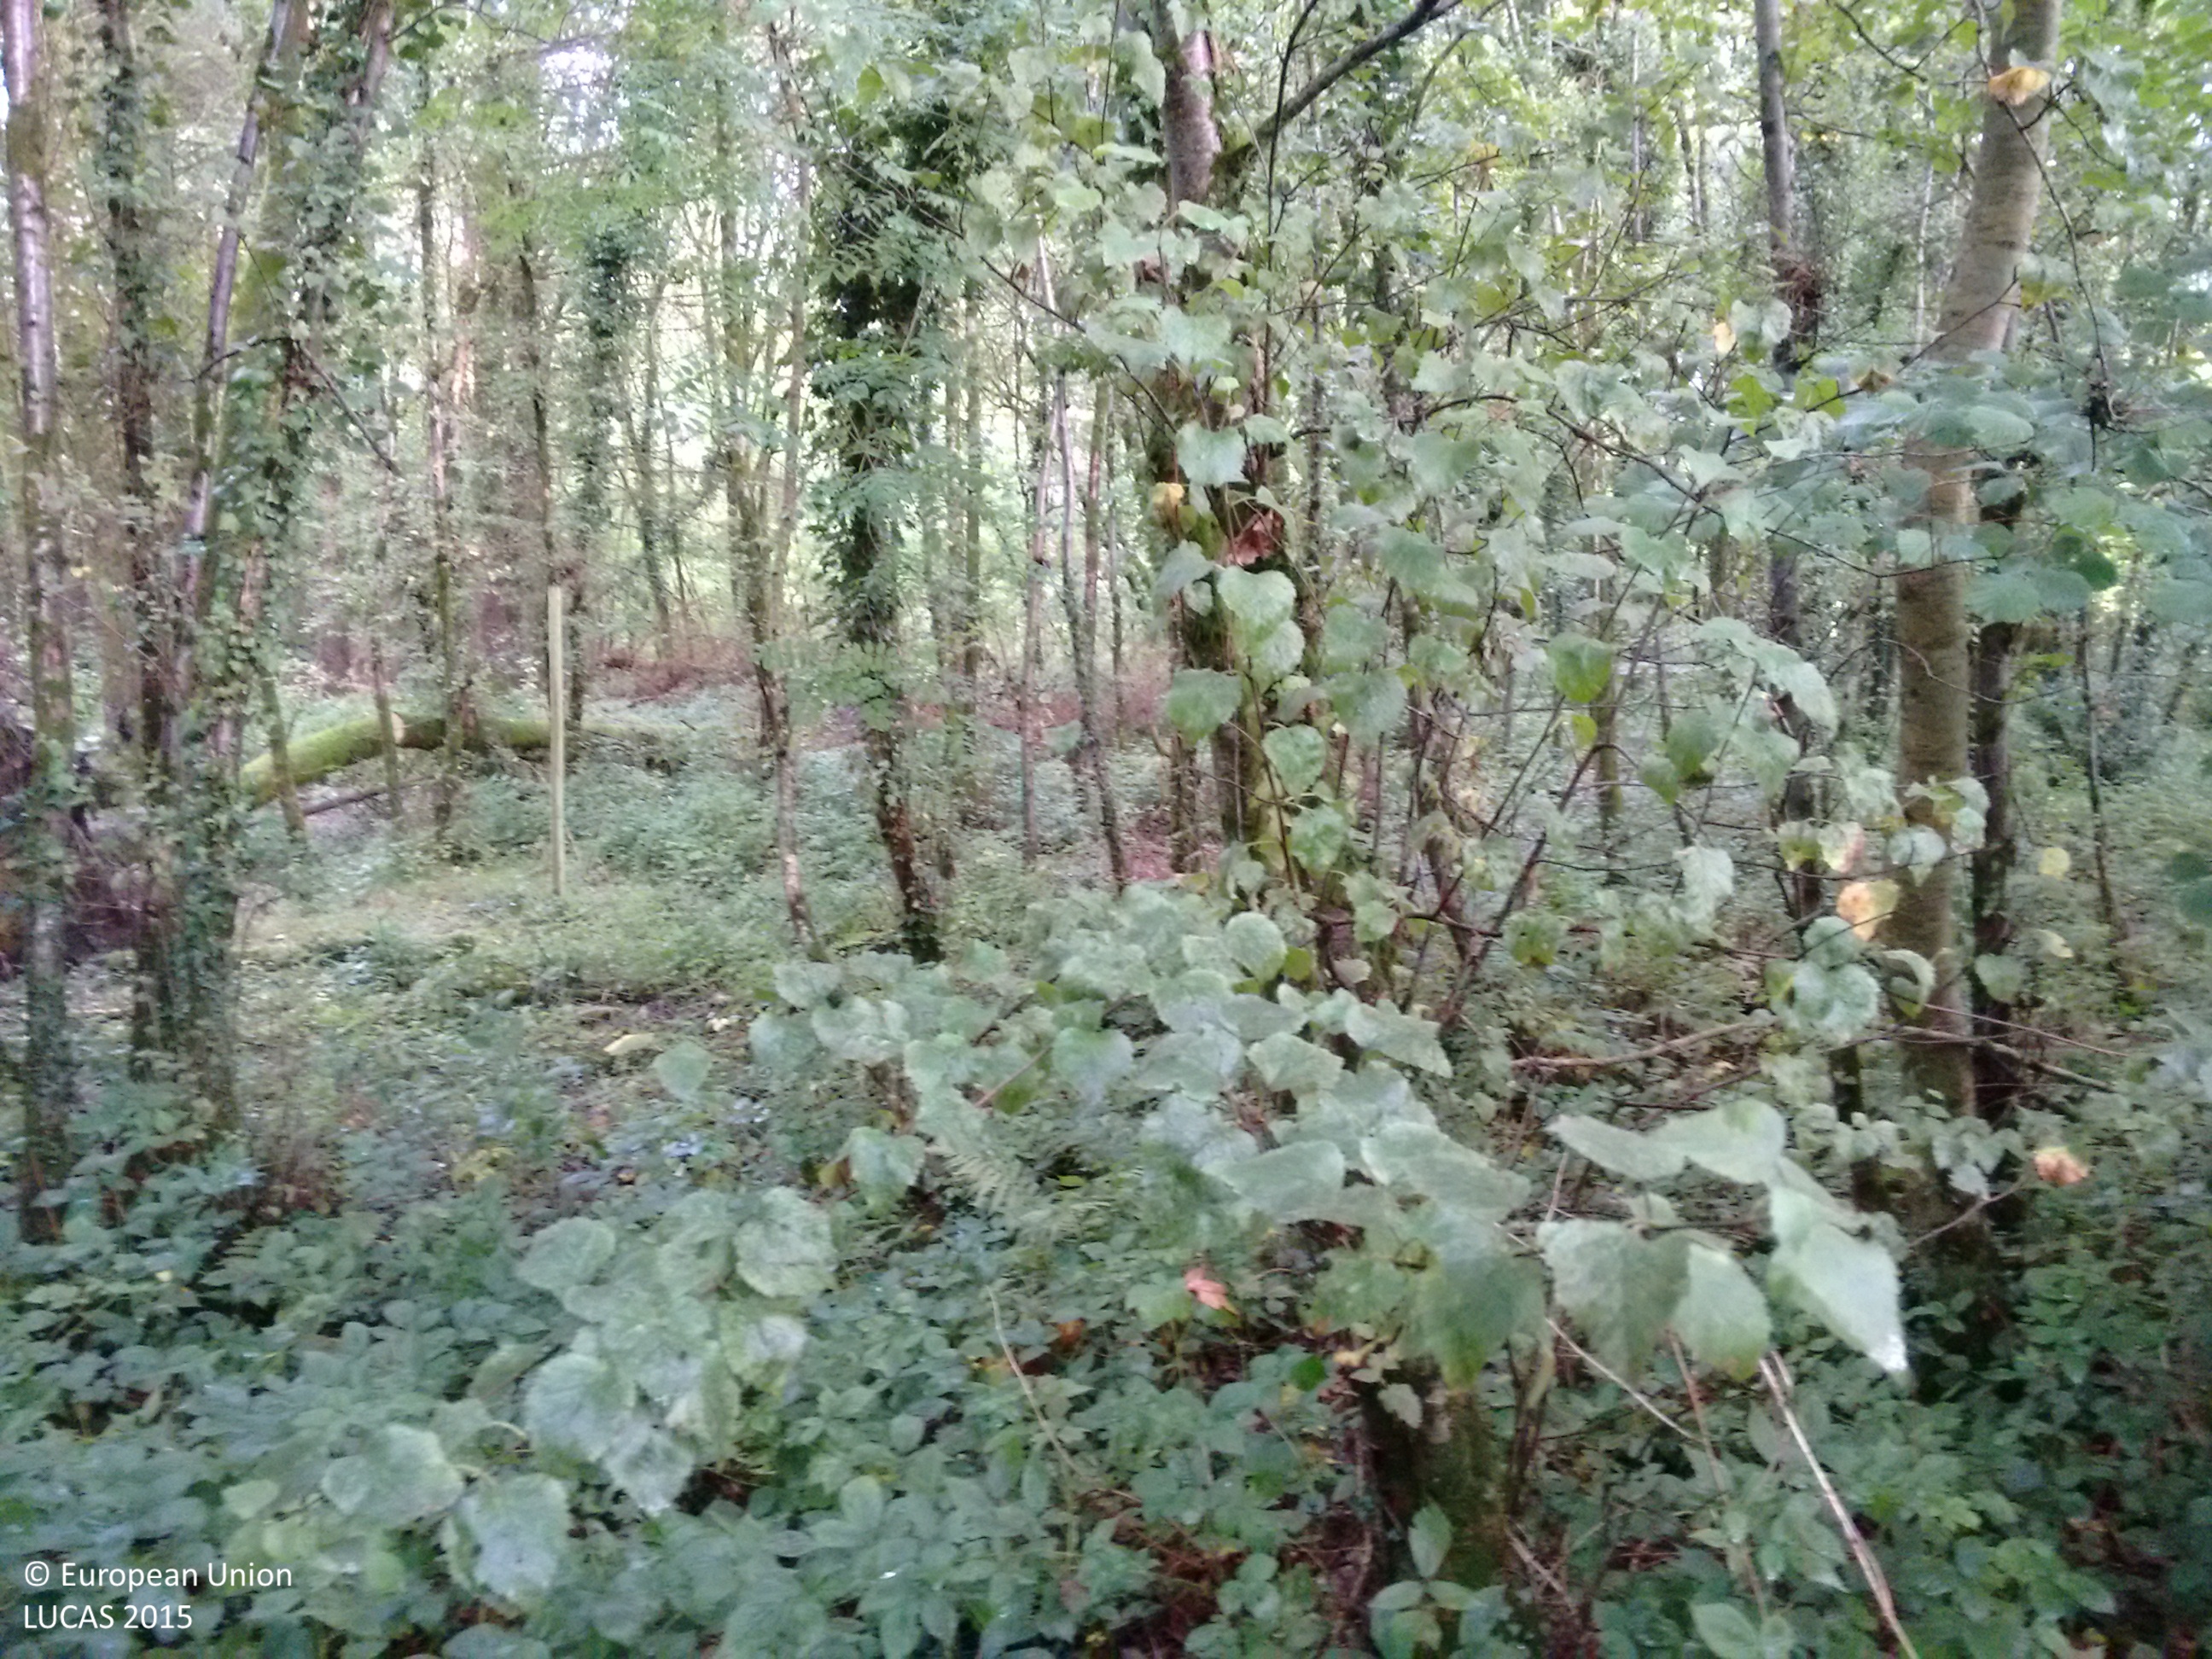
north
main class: Woodland
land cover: Broadleaved woodland
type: mesophytic deciduous forest
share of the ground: > 75 %
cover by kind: broadleaved forest trees 100 %
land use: Semi-natural and natural areas not in use
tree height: > 5 m
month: September
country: GB
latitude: 50.6769
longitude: -4.3518
